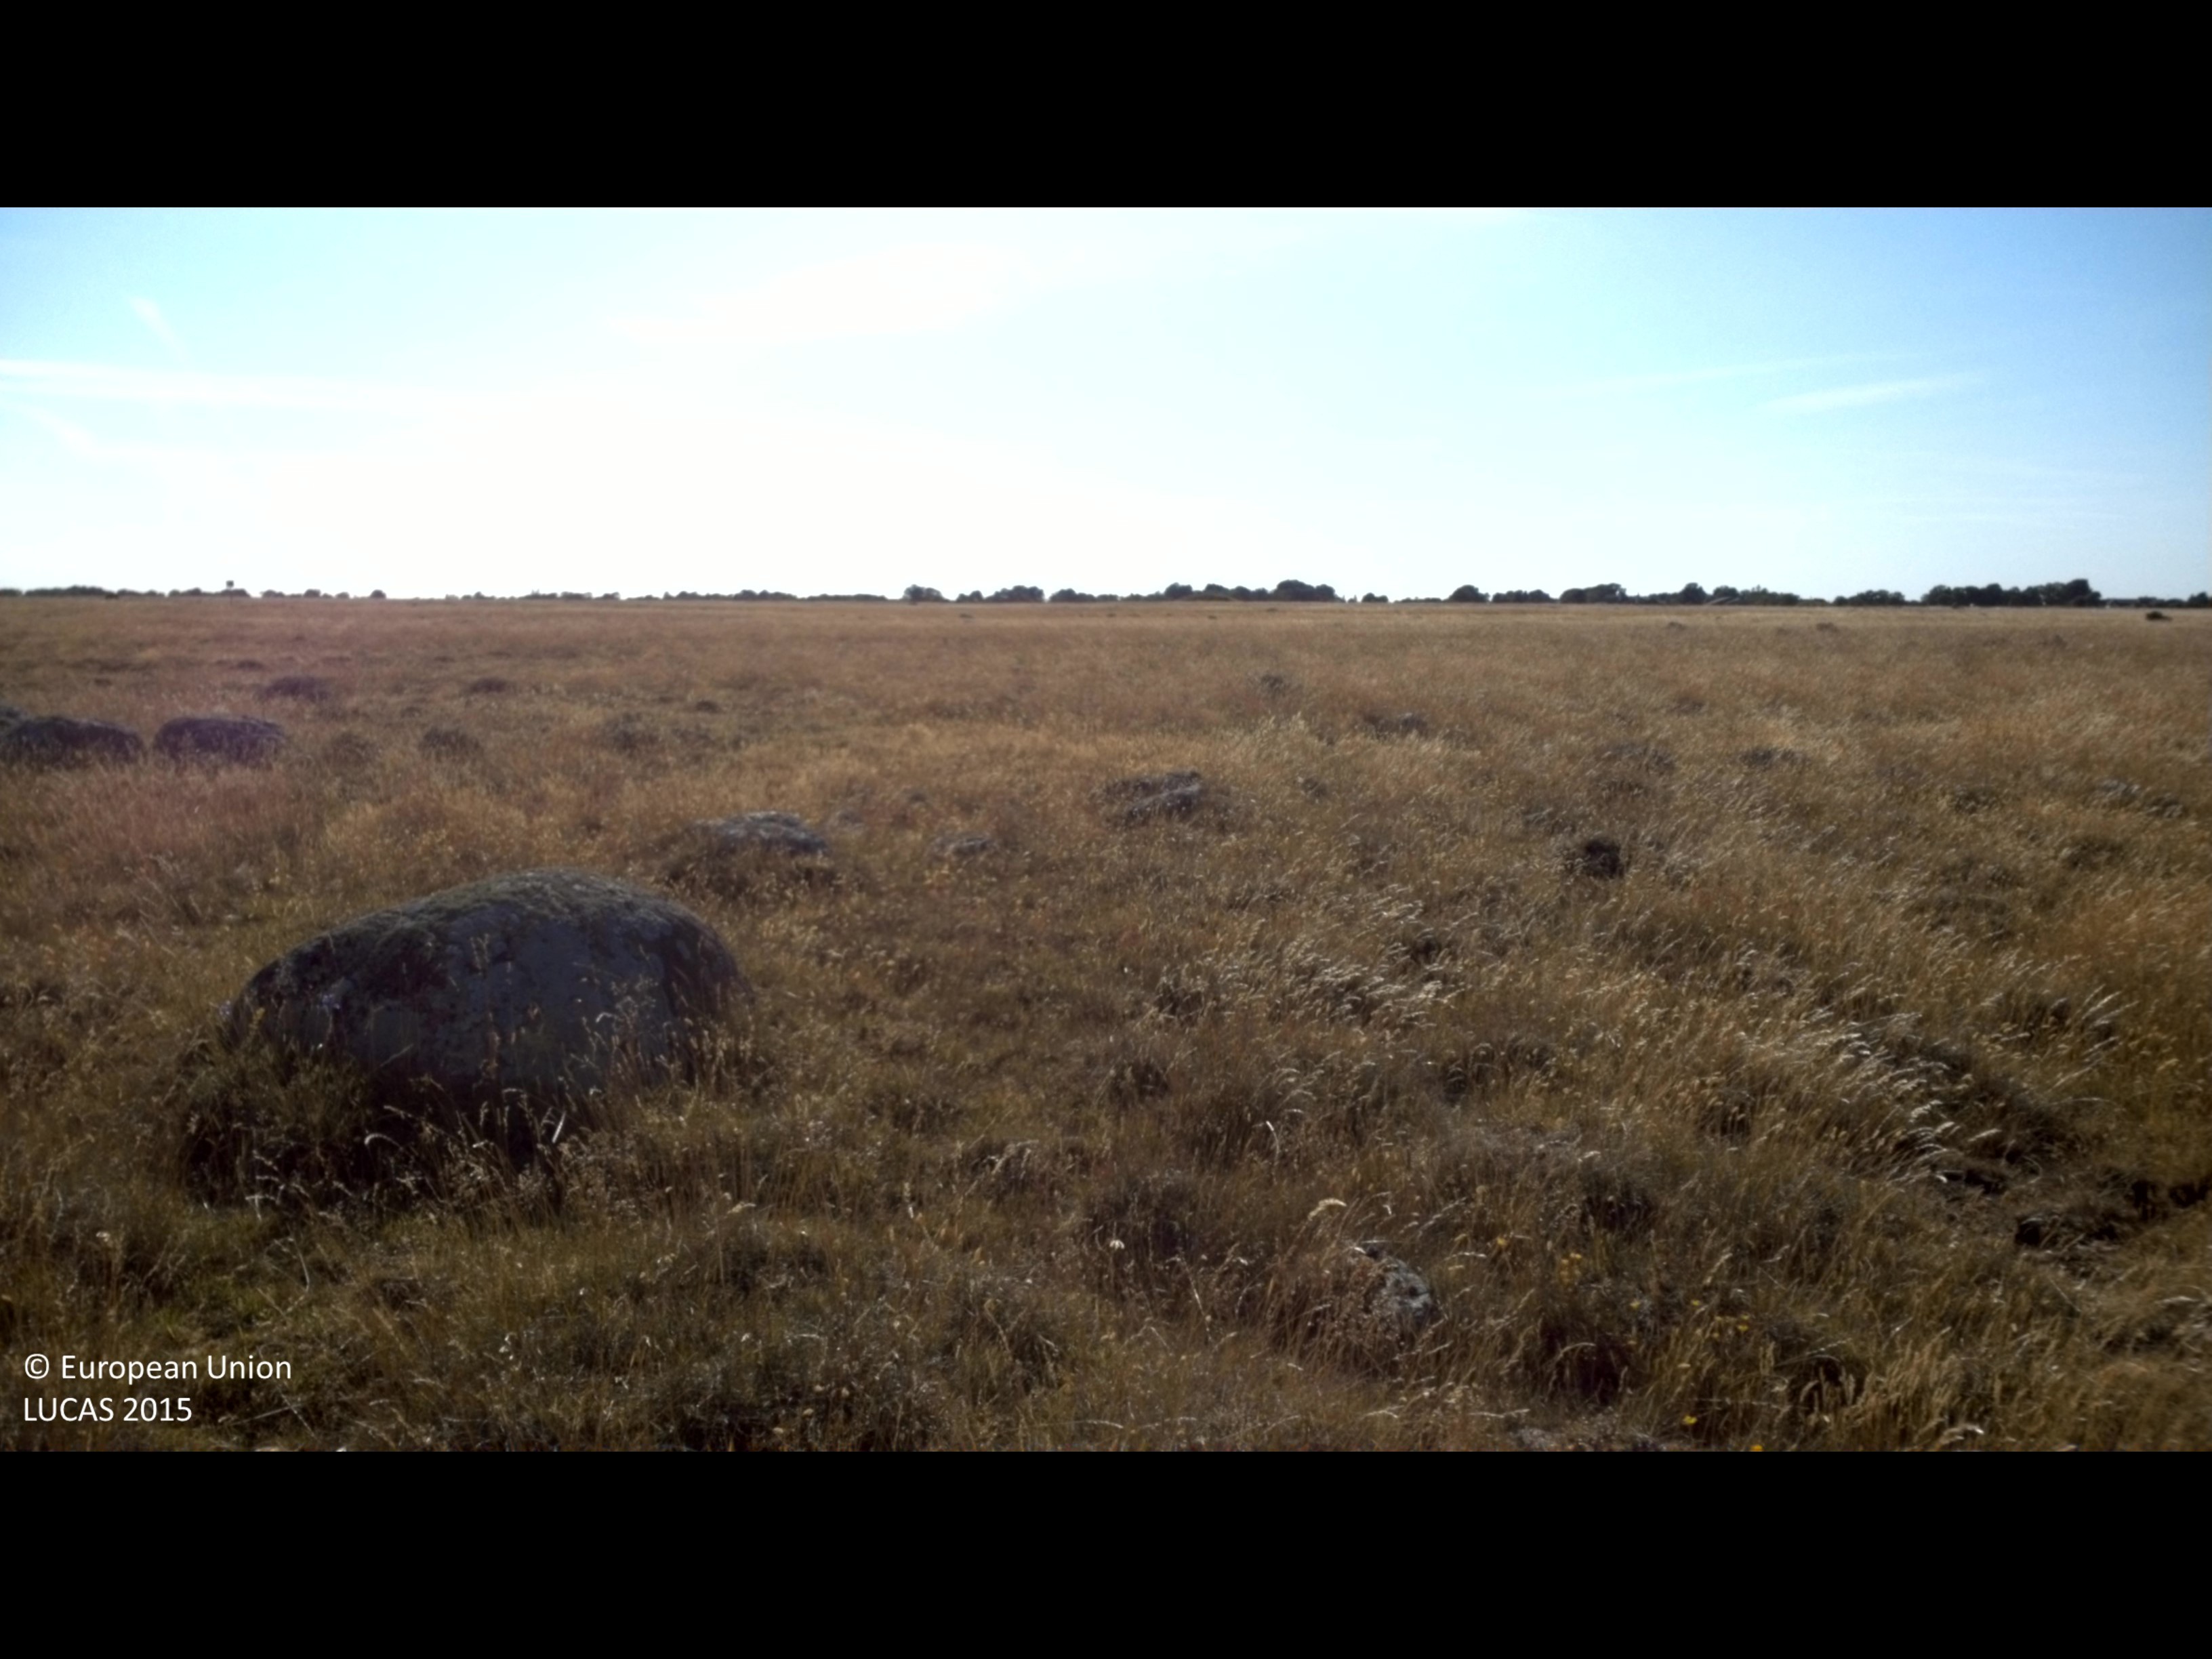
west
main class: Grassland
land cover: Grassland without tree/shrub cover
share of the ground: > 75 %
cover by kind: herbaceous plants 100 %
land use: Agriculture (excluding fallow land and kitchen gardens)
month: July
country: SE
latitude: 56.5044
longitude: 16.6148
